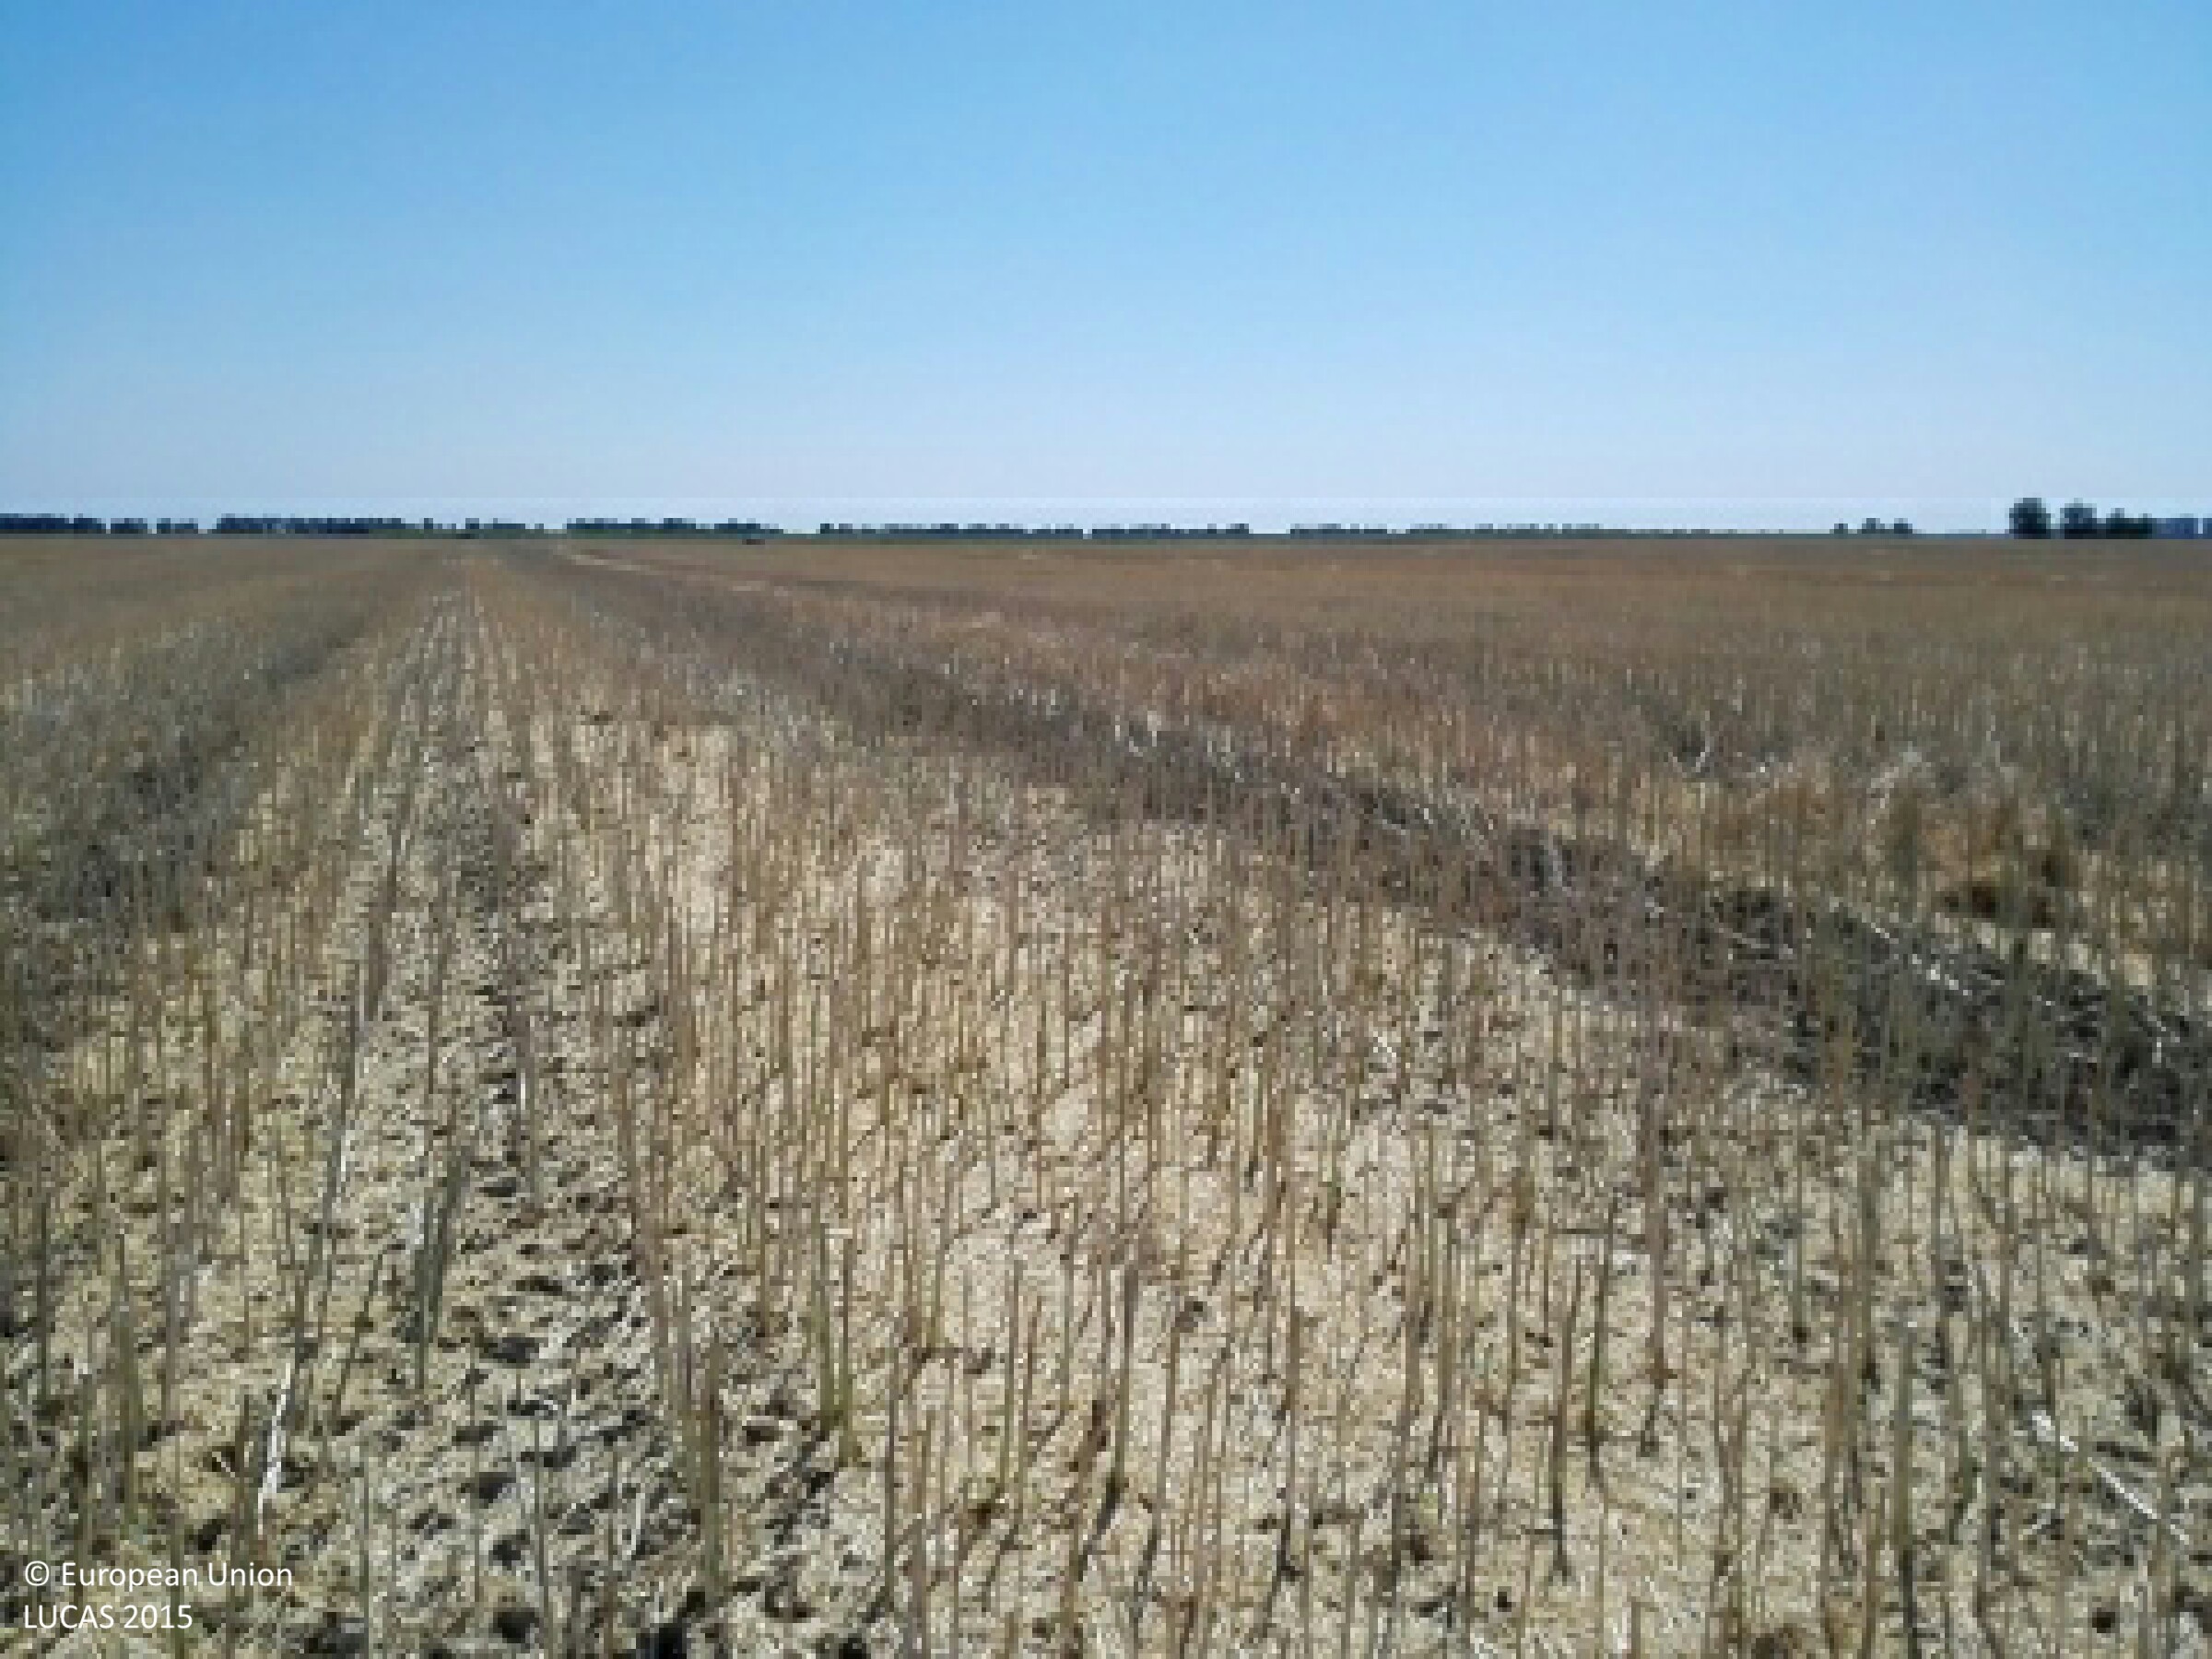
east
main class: Cropland
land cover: Rape and turnip rape
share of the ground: > 75 %
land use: Agriculture (excluding fallow land and kitchen gardens)
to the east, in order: Rape and turnip rape
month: July
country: HU
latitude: 47.7522
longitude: 21.4482
